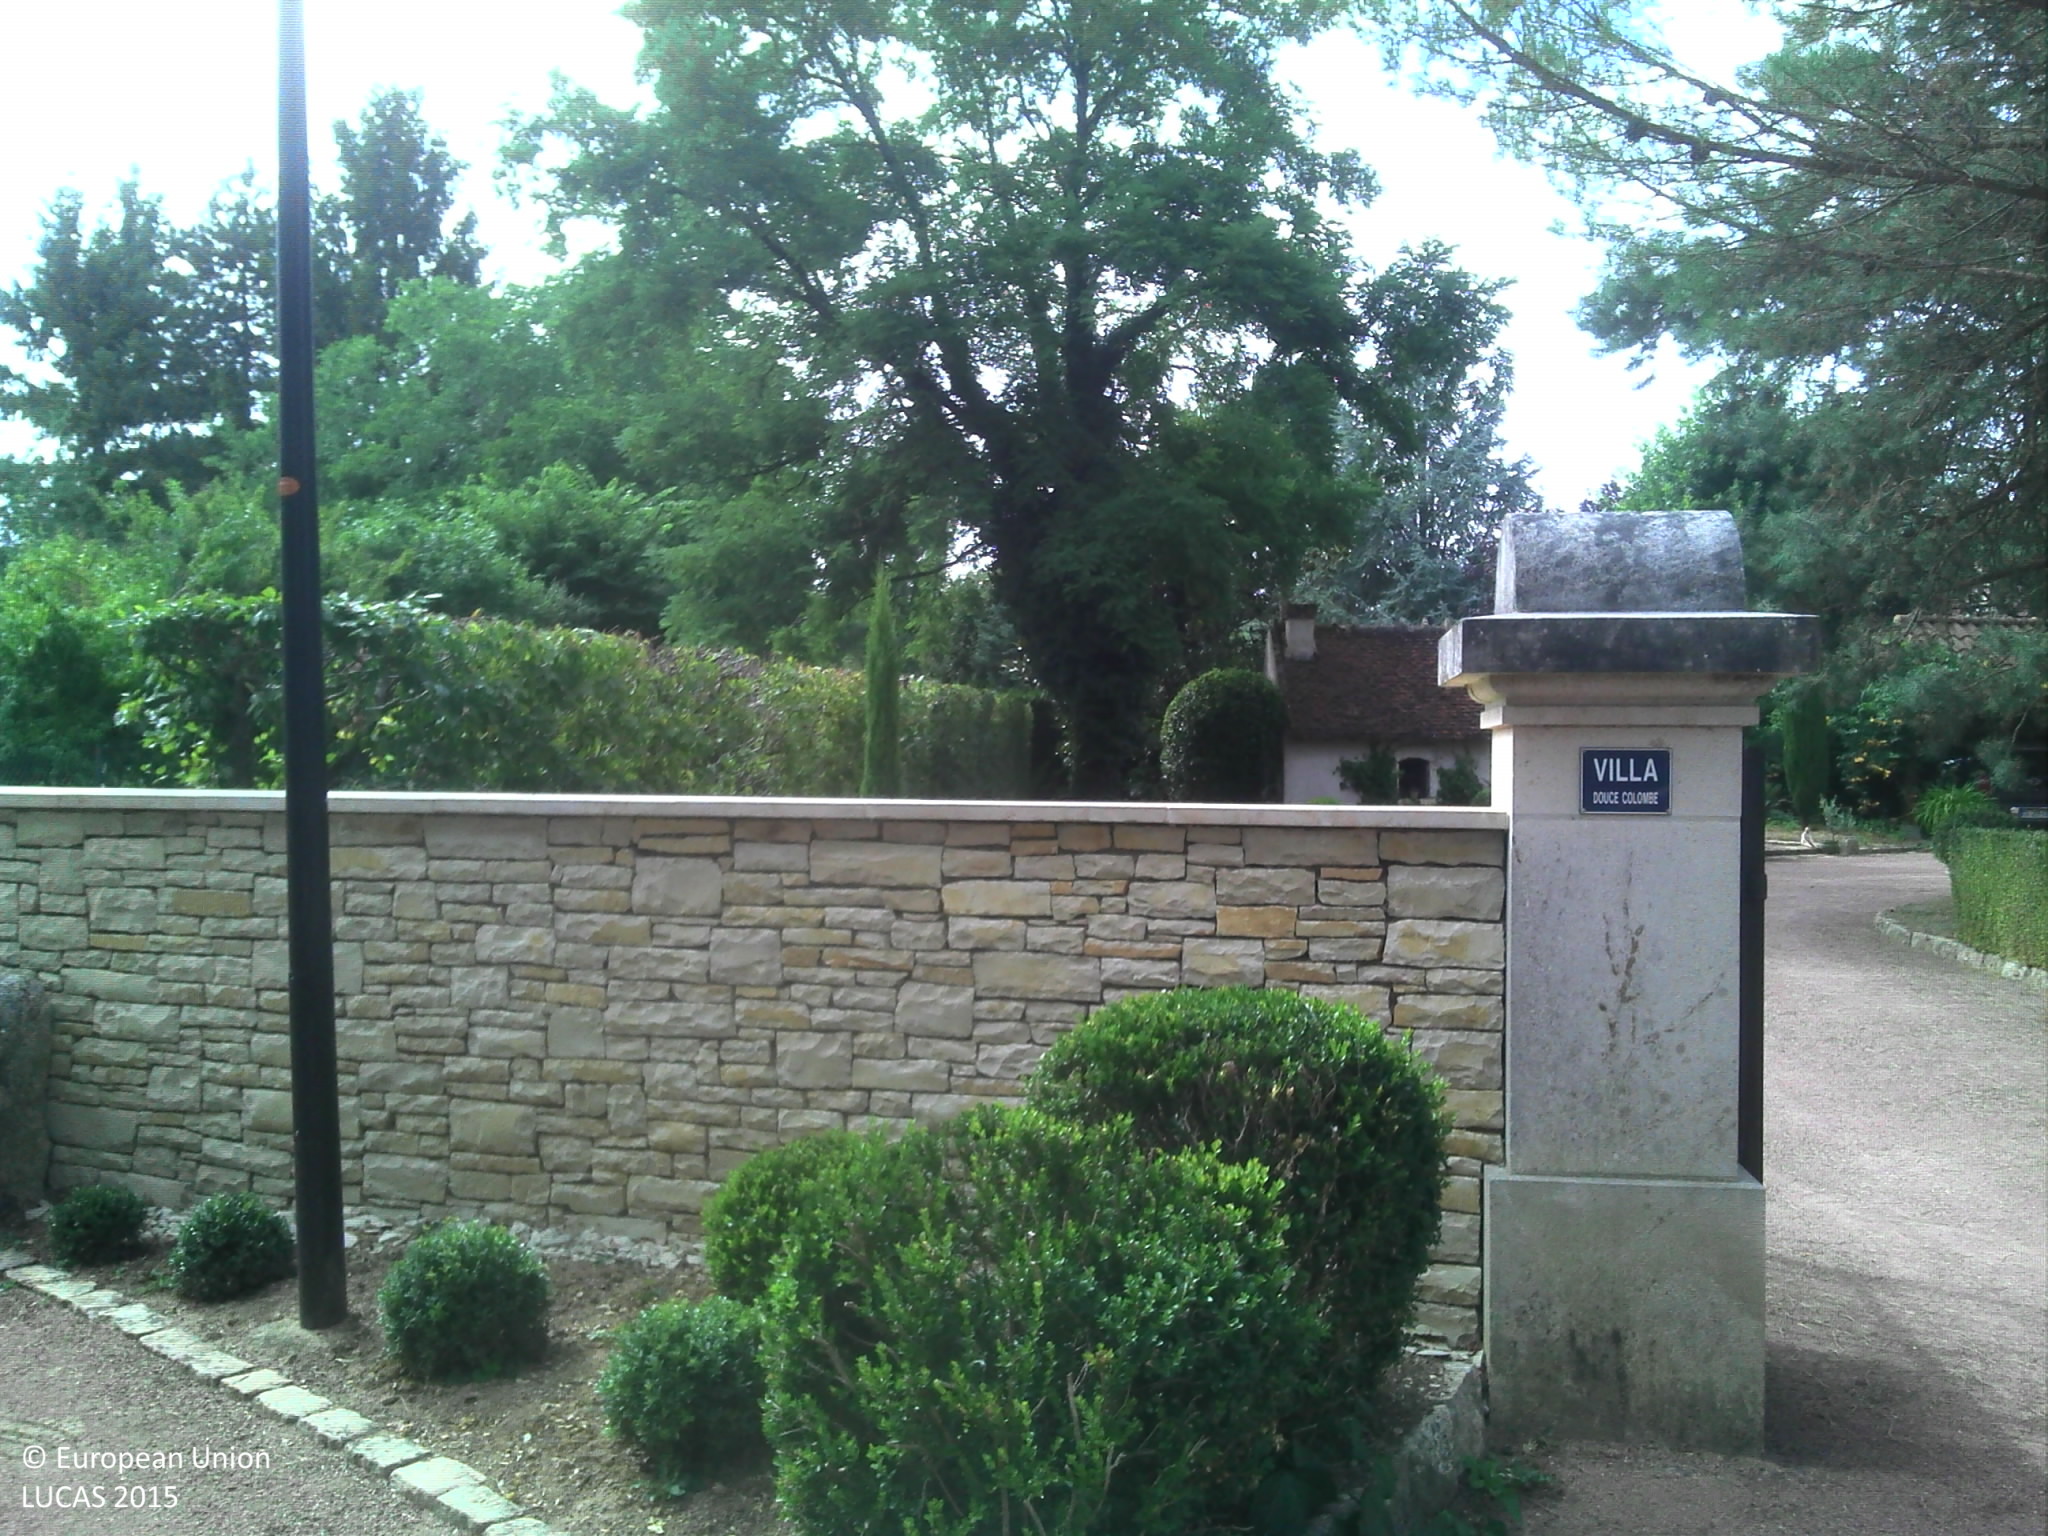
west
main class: Woodland
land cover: Broadleaved woodland
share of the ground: > 75 %
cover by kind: broadleaved forest trees 65 %, herbaceous plants 35 %
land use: Residential
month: July
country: FR
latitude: 46.8009
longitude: 4.7732
